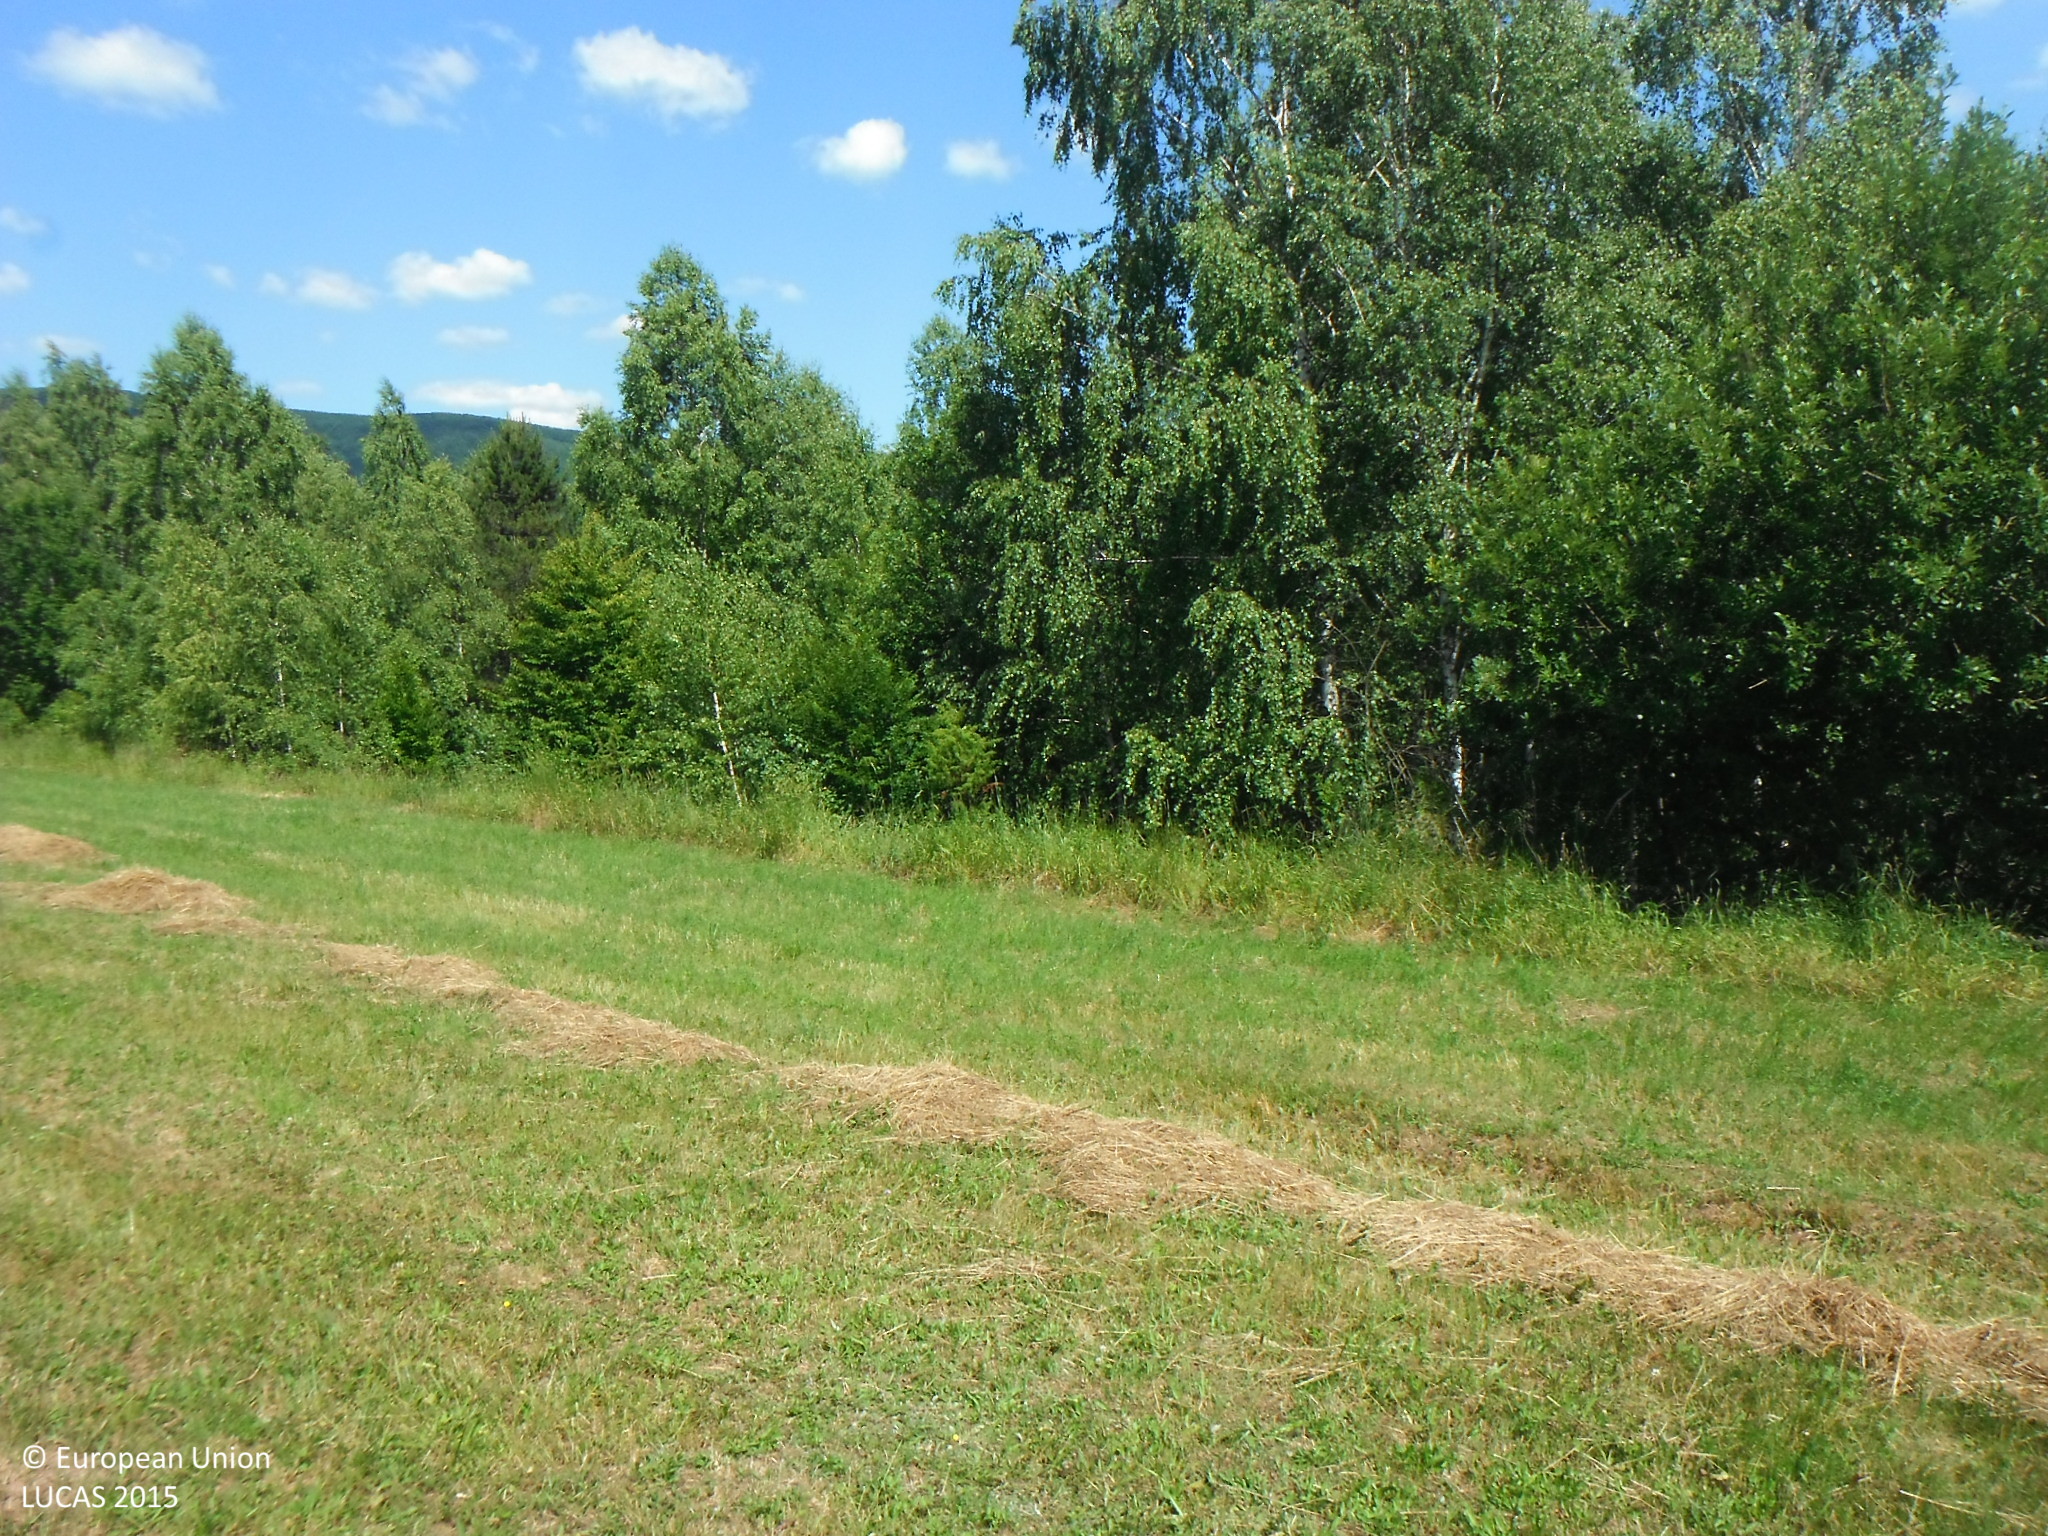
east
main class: Grassland
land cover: Grassland without tree/shrub cover
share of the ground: > 75 %
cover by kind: herbaceous plants 100 %
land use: Agriculture (excluding fallow land and kitchen gardens)
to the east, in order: Grassland without tree/shrub cover; Broadleaved woodland; Grassland without tree/shrub cover; Broadleaved woodland; Grassland without tree/shrub cover; Broadleaved woodland; Rivers and streams; Broadleaved woodland; Spontaneously vegetated surfaces
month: July
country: SK
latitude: 49.0680
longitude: 22.3942
